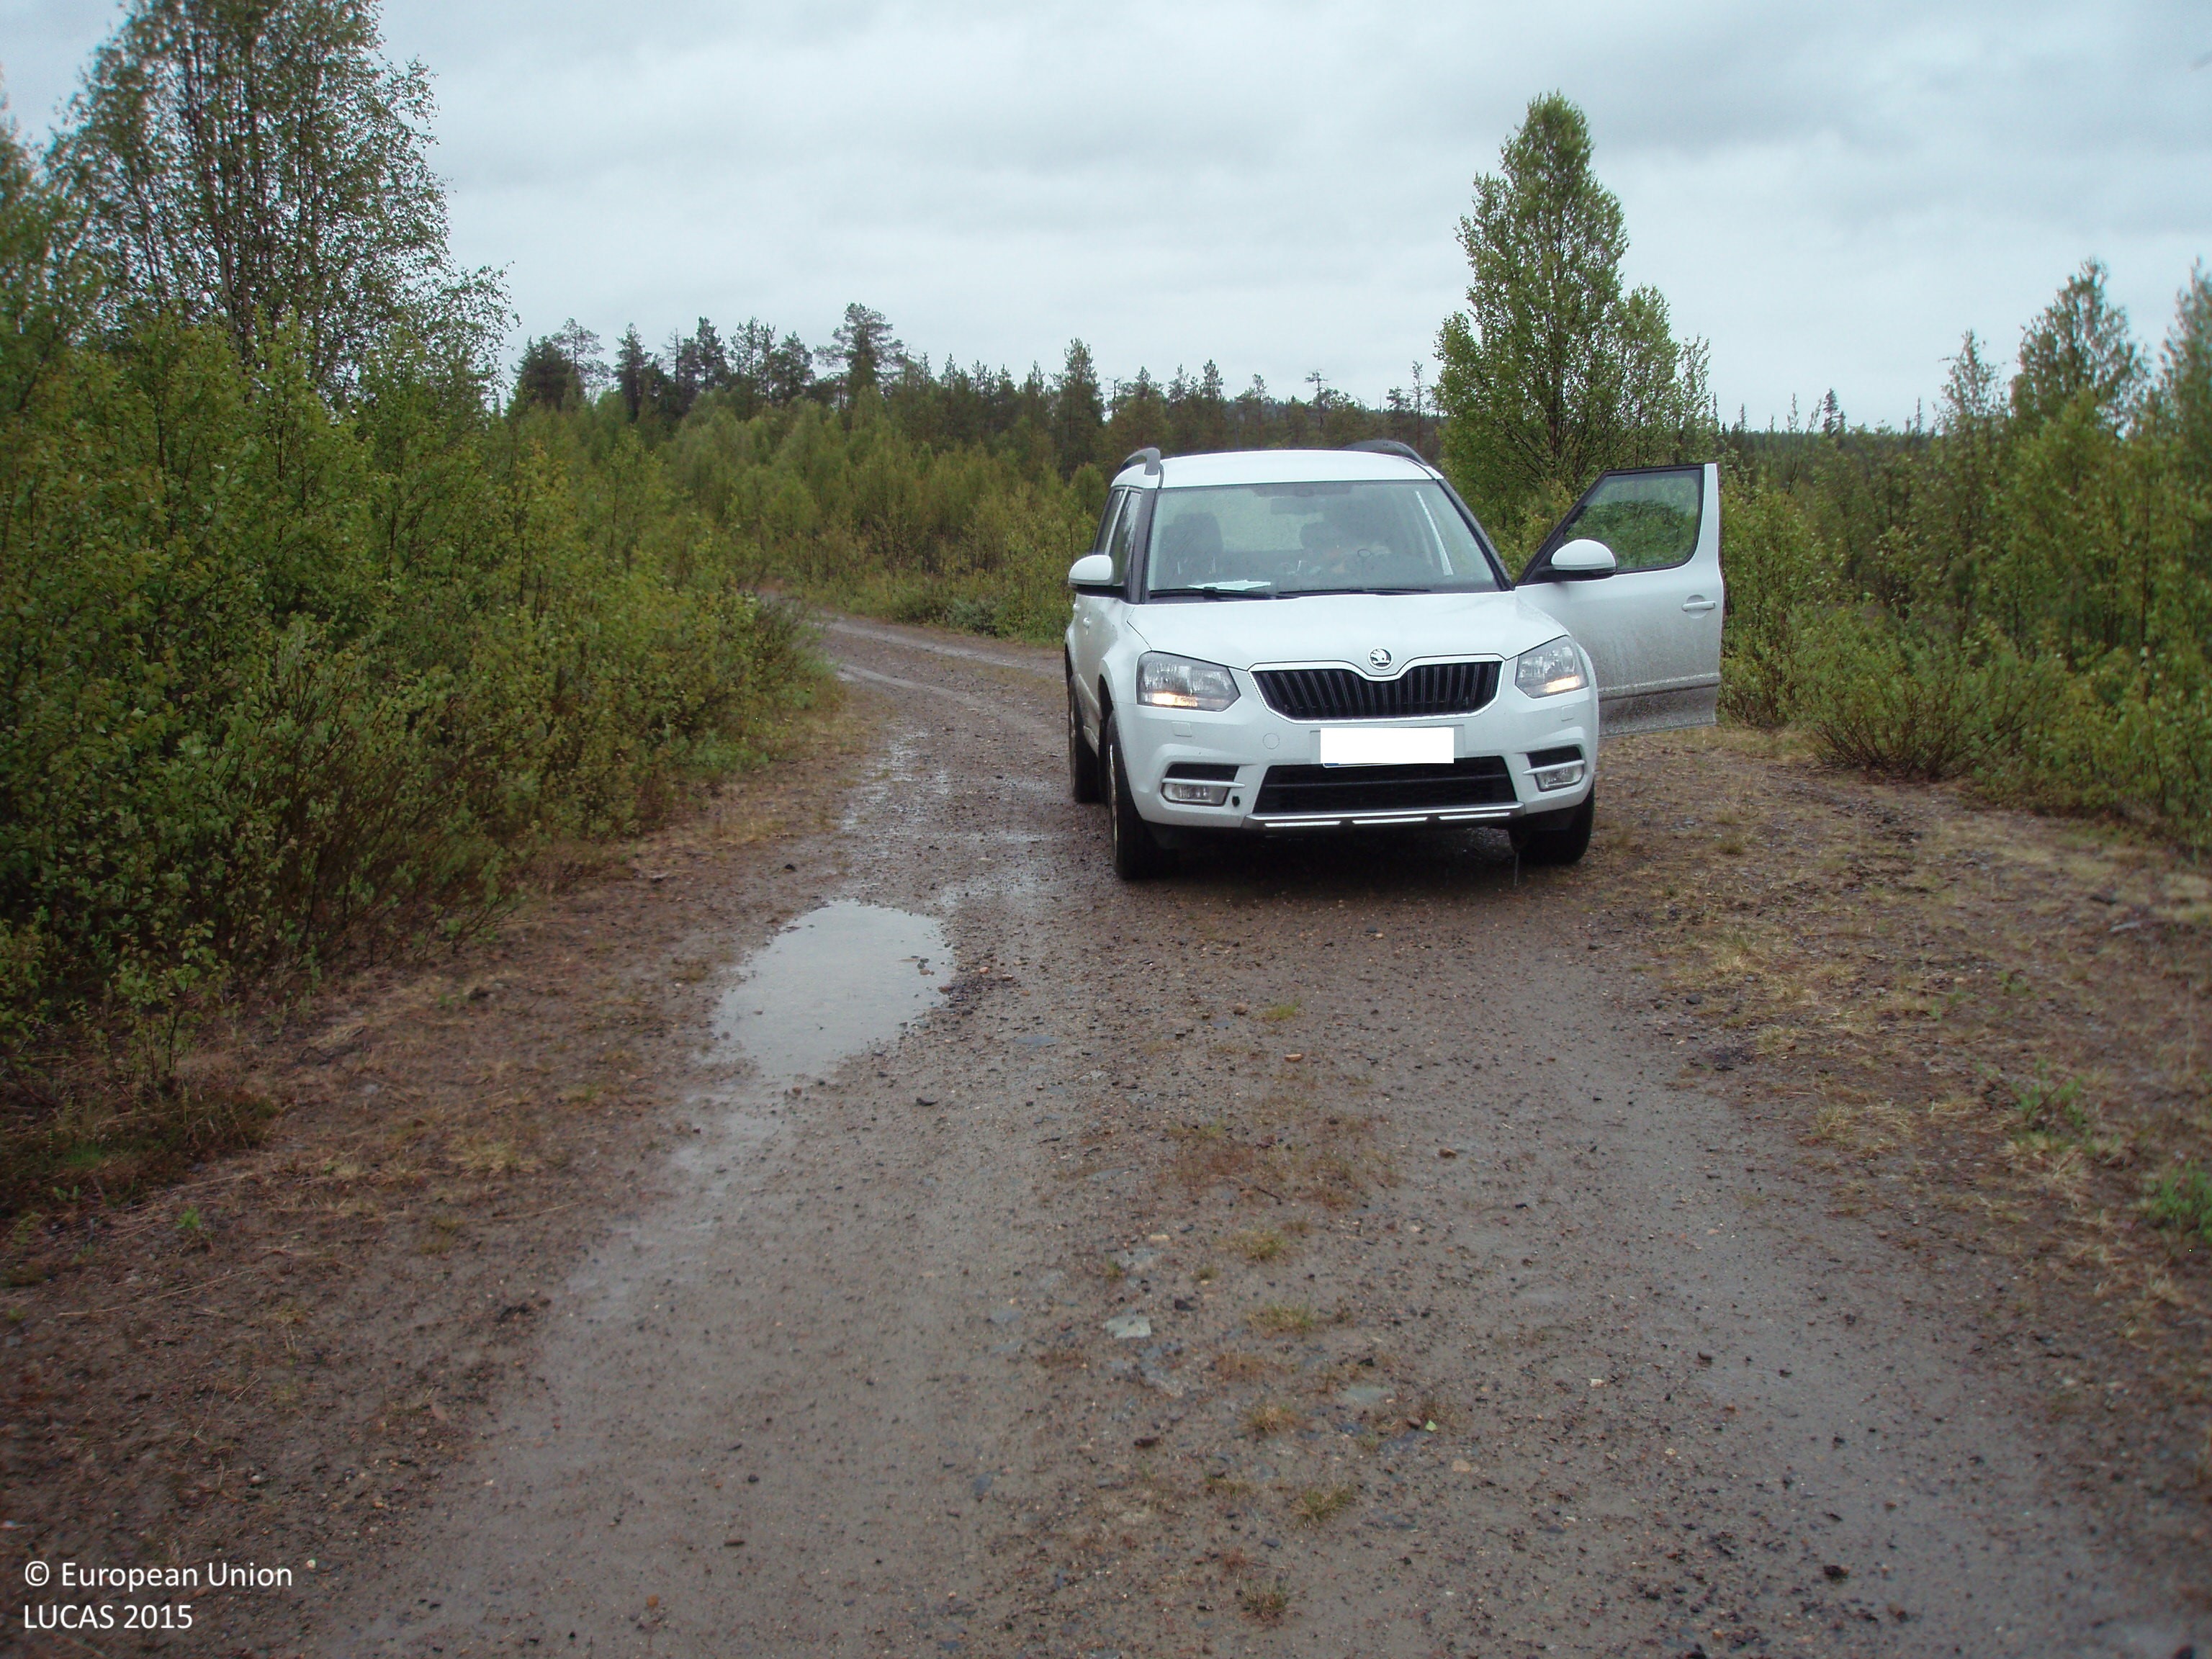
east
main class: Woodland
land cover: Pine dominated mixed woodland
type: boreal forest
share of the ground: 25 - 50 %
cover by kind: shrubs 50 %, broadleaved forest trees 25 %, coniferous forest trees 20 %, herbaceous plants 5 %
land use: Forestry
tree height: > 5 m
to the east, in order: Pine dominated mixed woodland; Pine dominated coniferous woodland
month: June
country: FI
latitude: 67.6478
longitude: 26.5405
